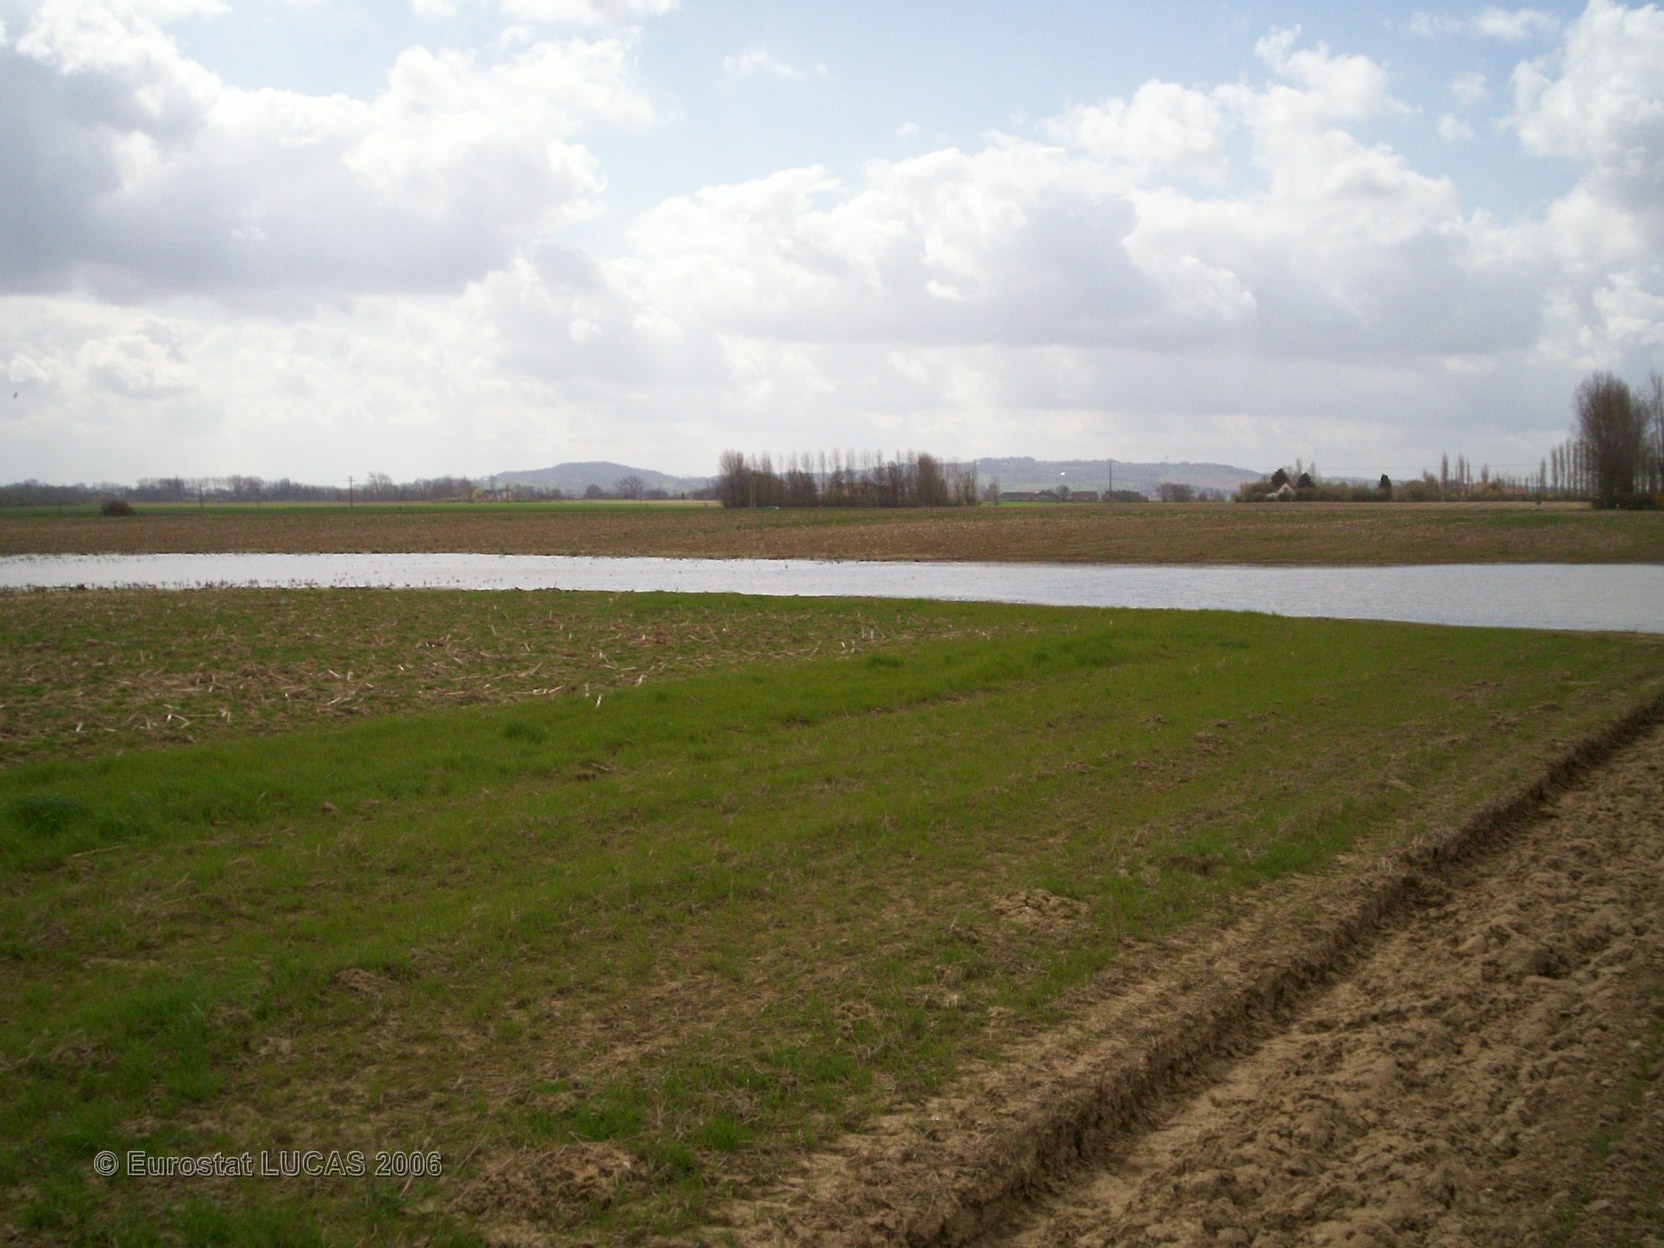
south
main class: Cropland
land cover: Common wheat
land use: Agriculture (excluding fallow land and kitchen gardens)
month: April
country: FR
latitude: 50.8581
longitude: 2.5005
